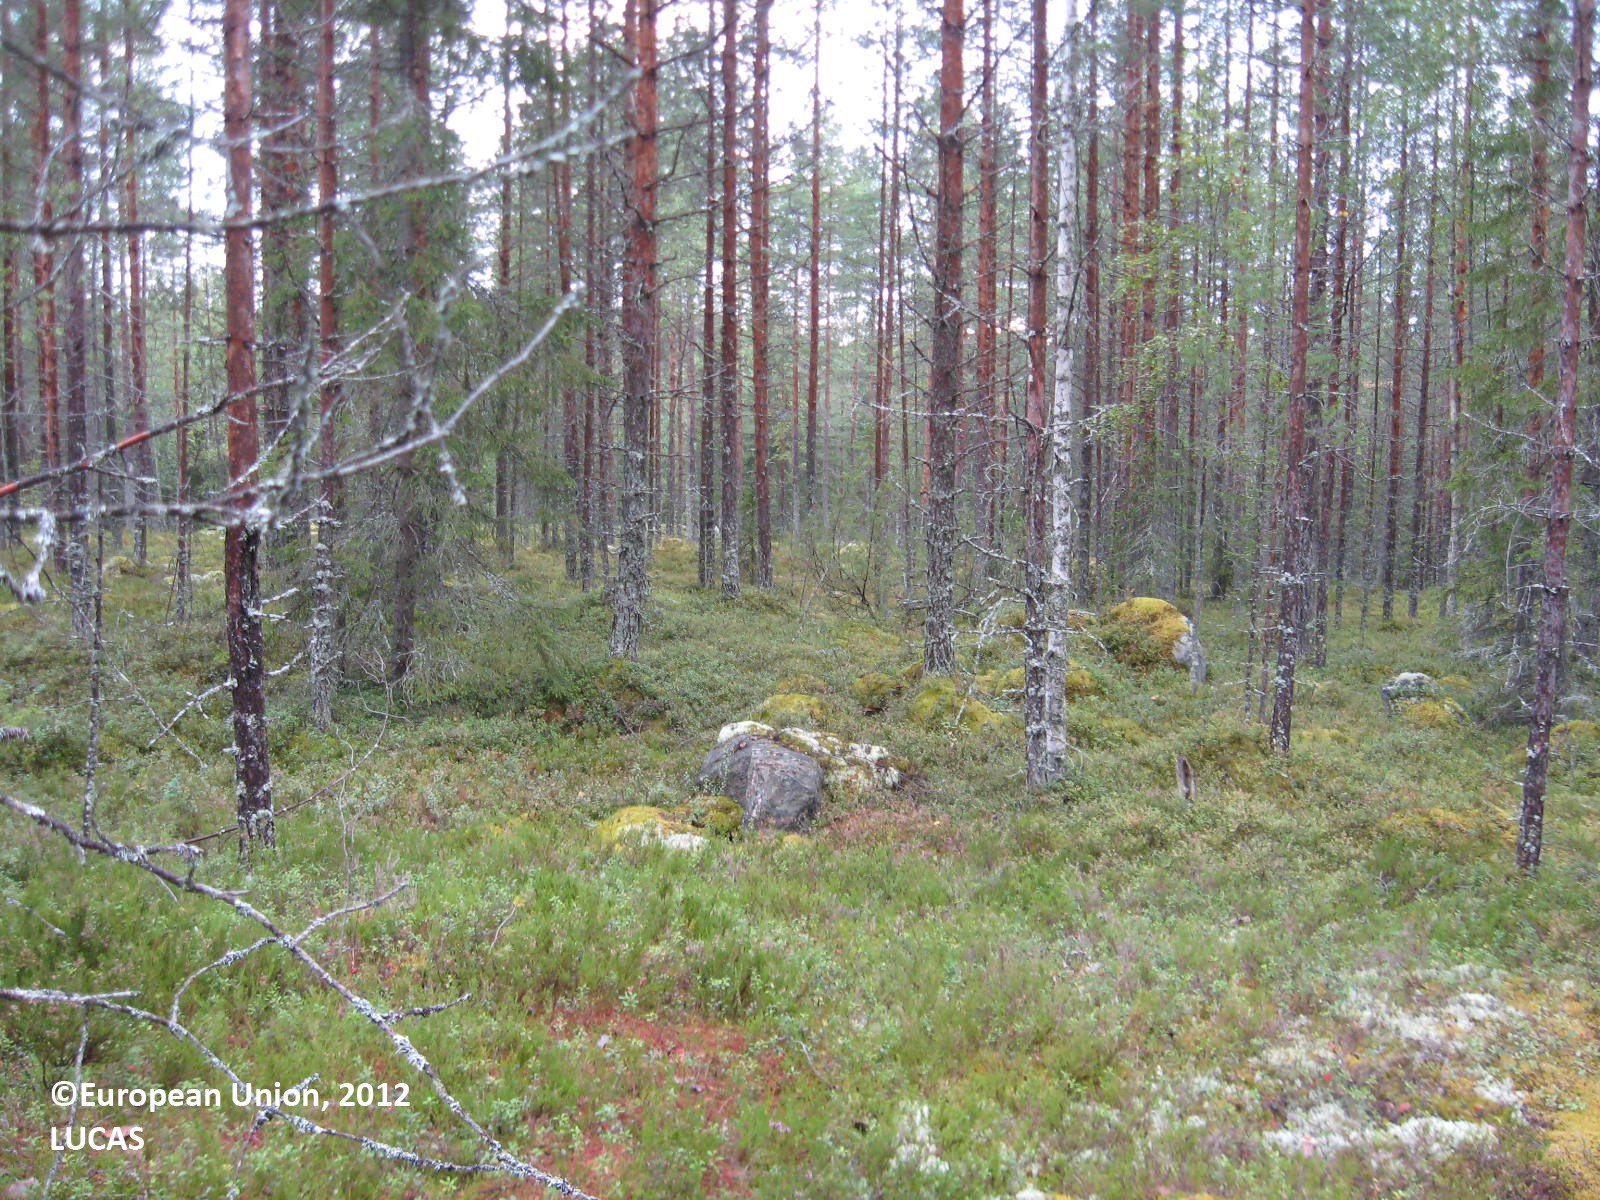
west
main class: Woodland
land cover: Pine dominated coniferous woodland
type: boreal forest
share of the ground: > 75 %
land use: Forestry
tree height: > 5 m
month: August
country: FI
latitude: 63.4859
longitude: 29.3559
